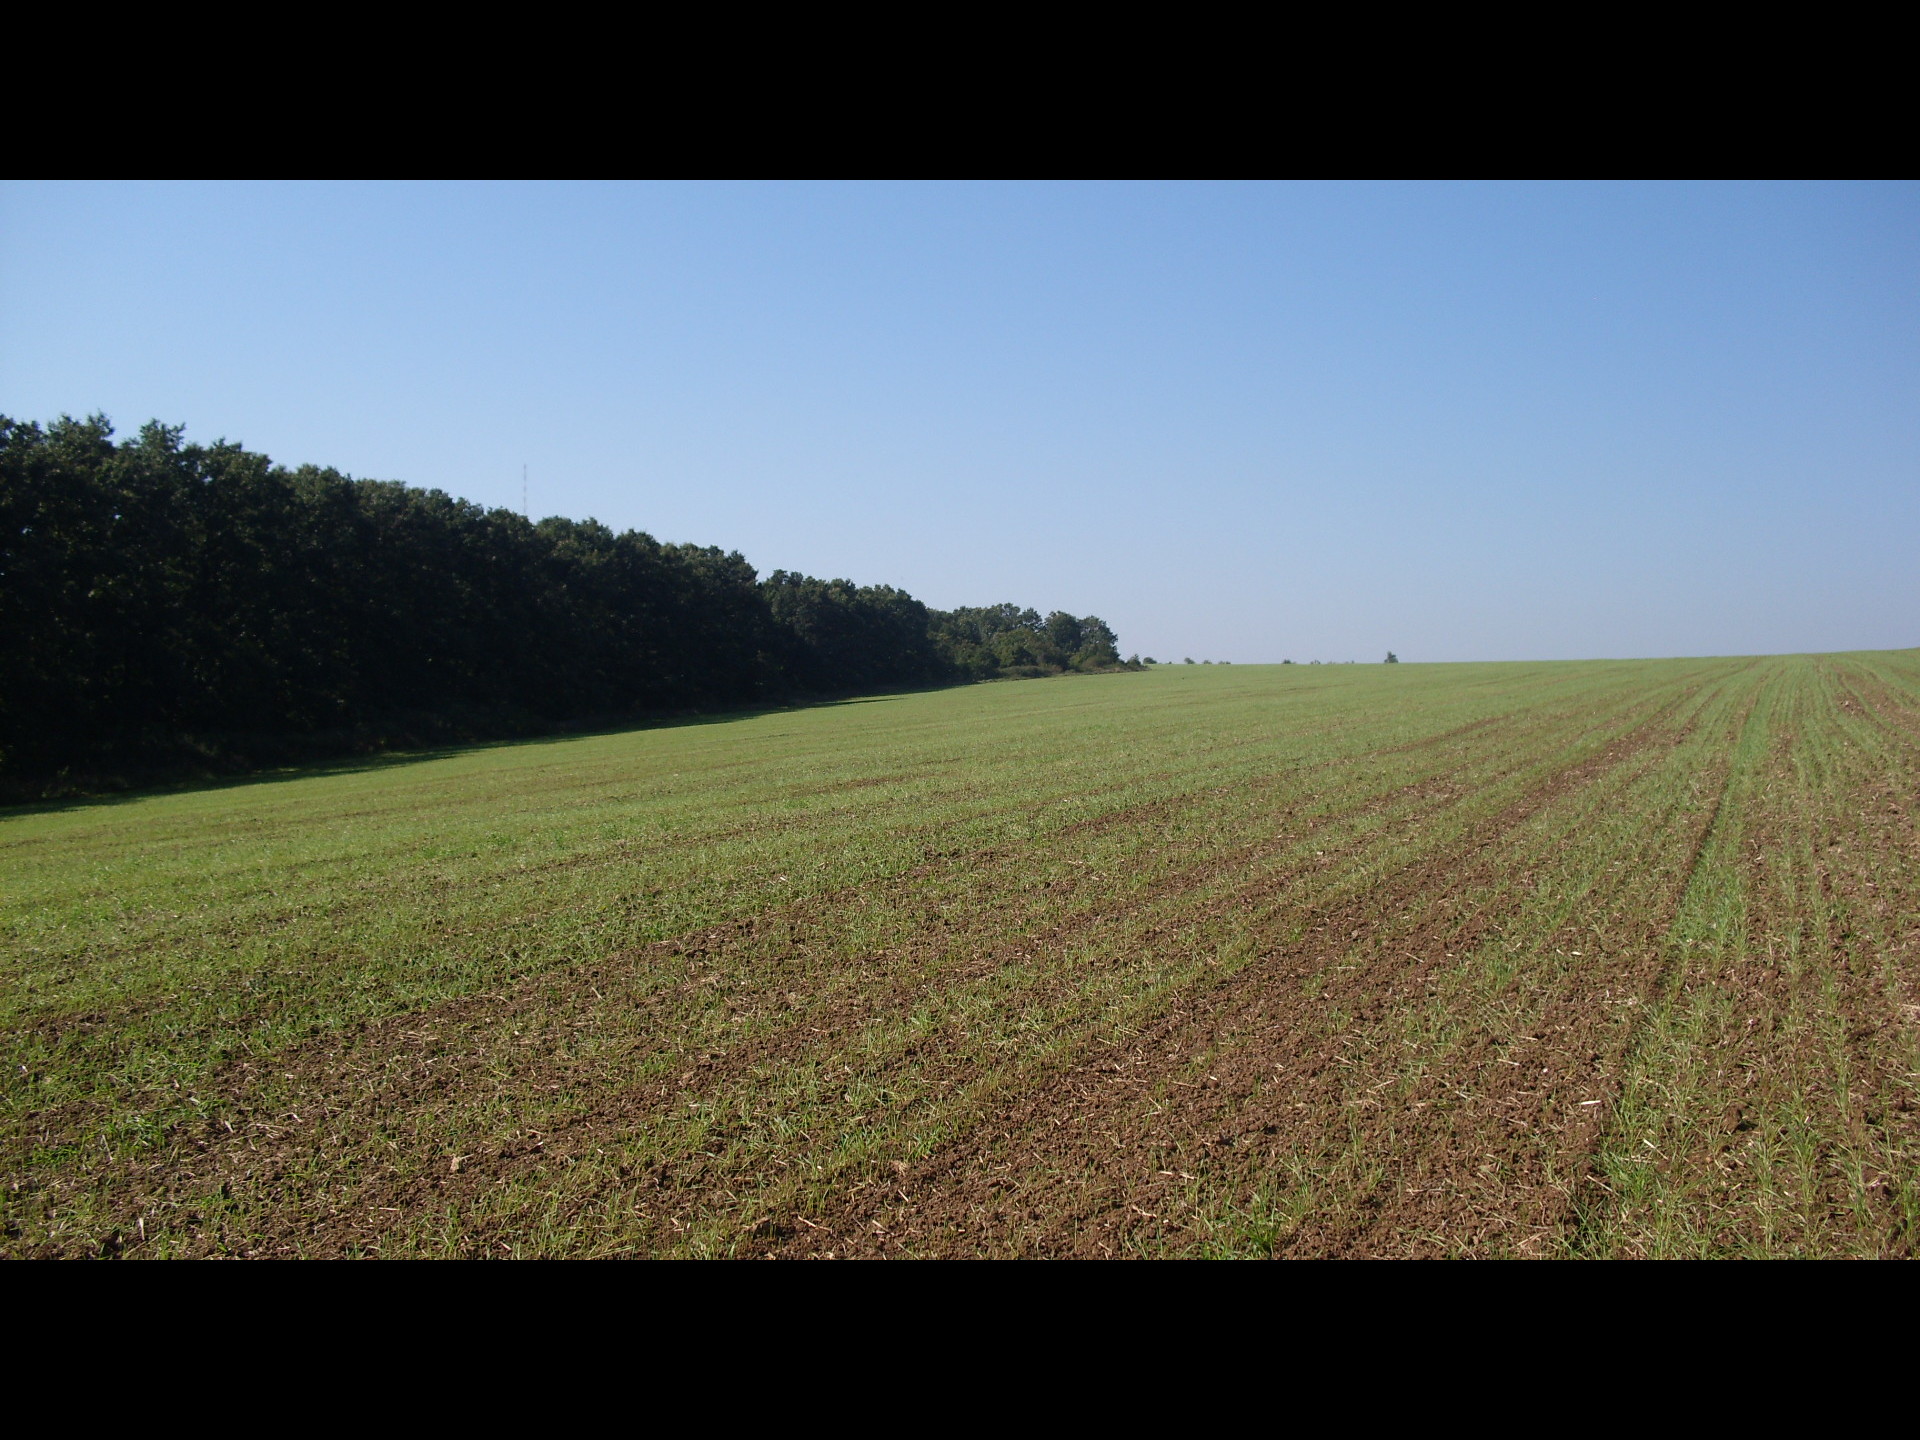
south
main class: Cropland
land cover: Common wheat
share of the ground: < 10 %
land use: Agriculture (excluding fallow land and kitchen gardens)
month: October
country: BG
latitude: 43.8538
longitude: 22.7381
